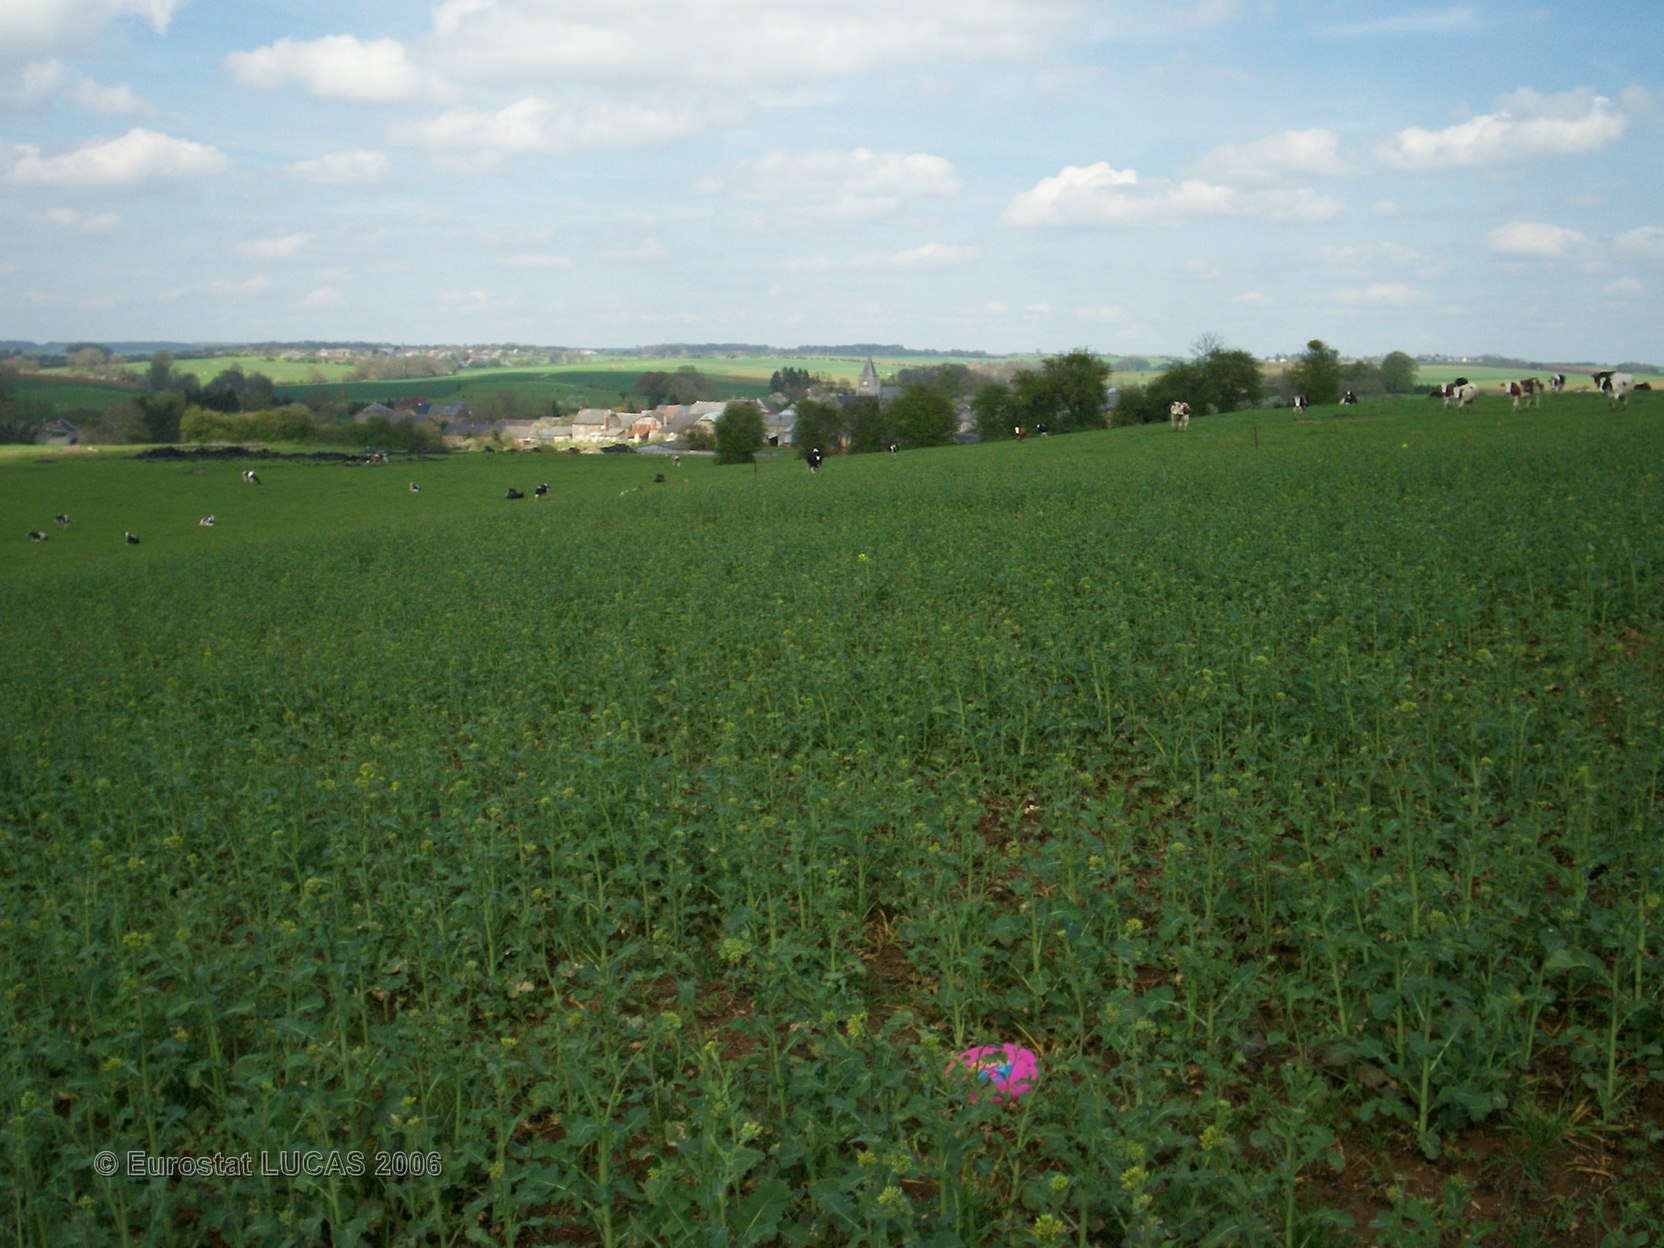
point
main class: Cropland
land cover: Rape and turnip rape
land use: Agriculture (excluding fallow land and kitchen gardens)
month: May
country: FR
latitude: 49.8438
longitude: 4.3080
